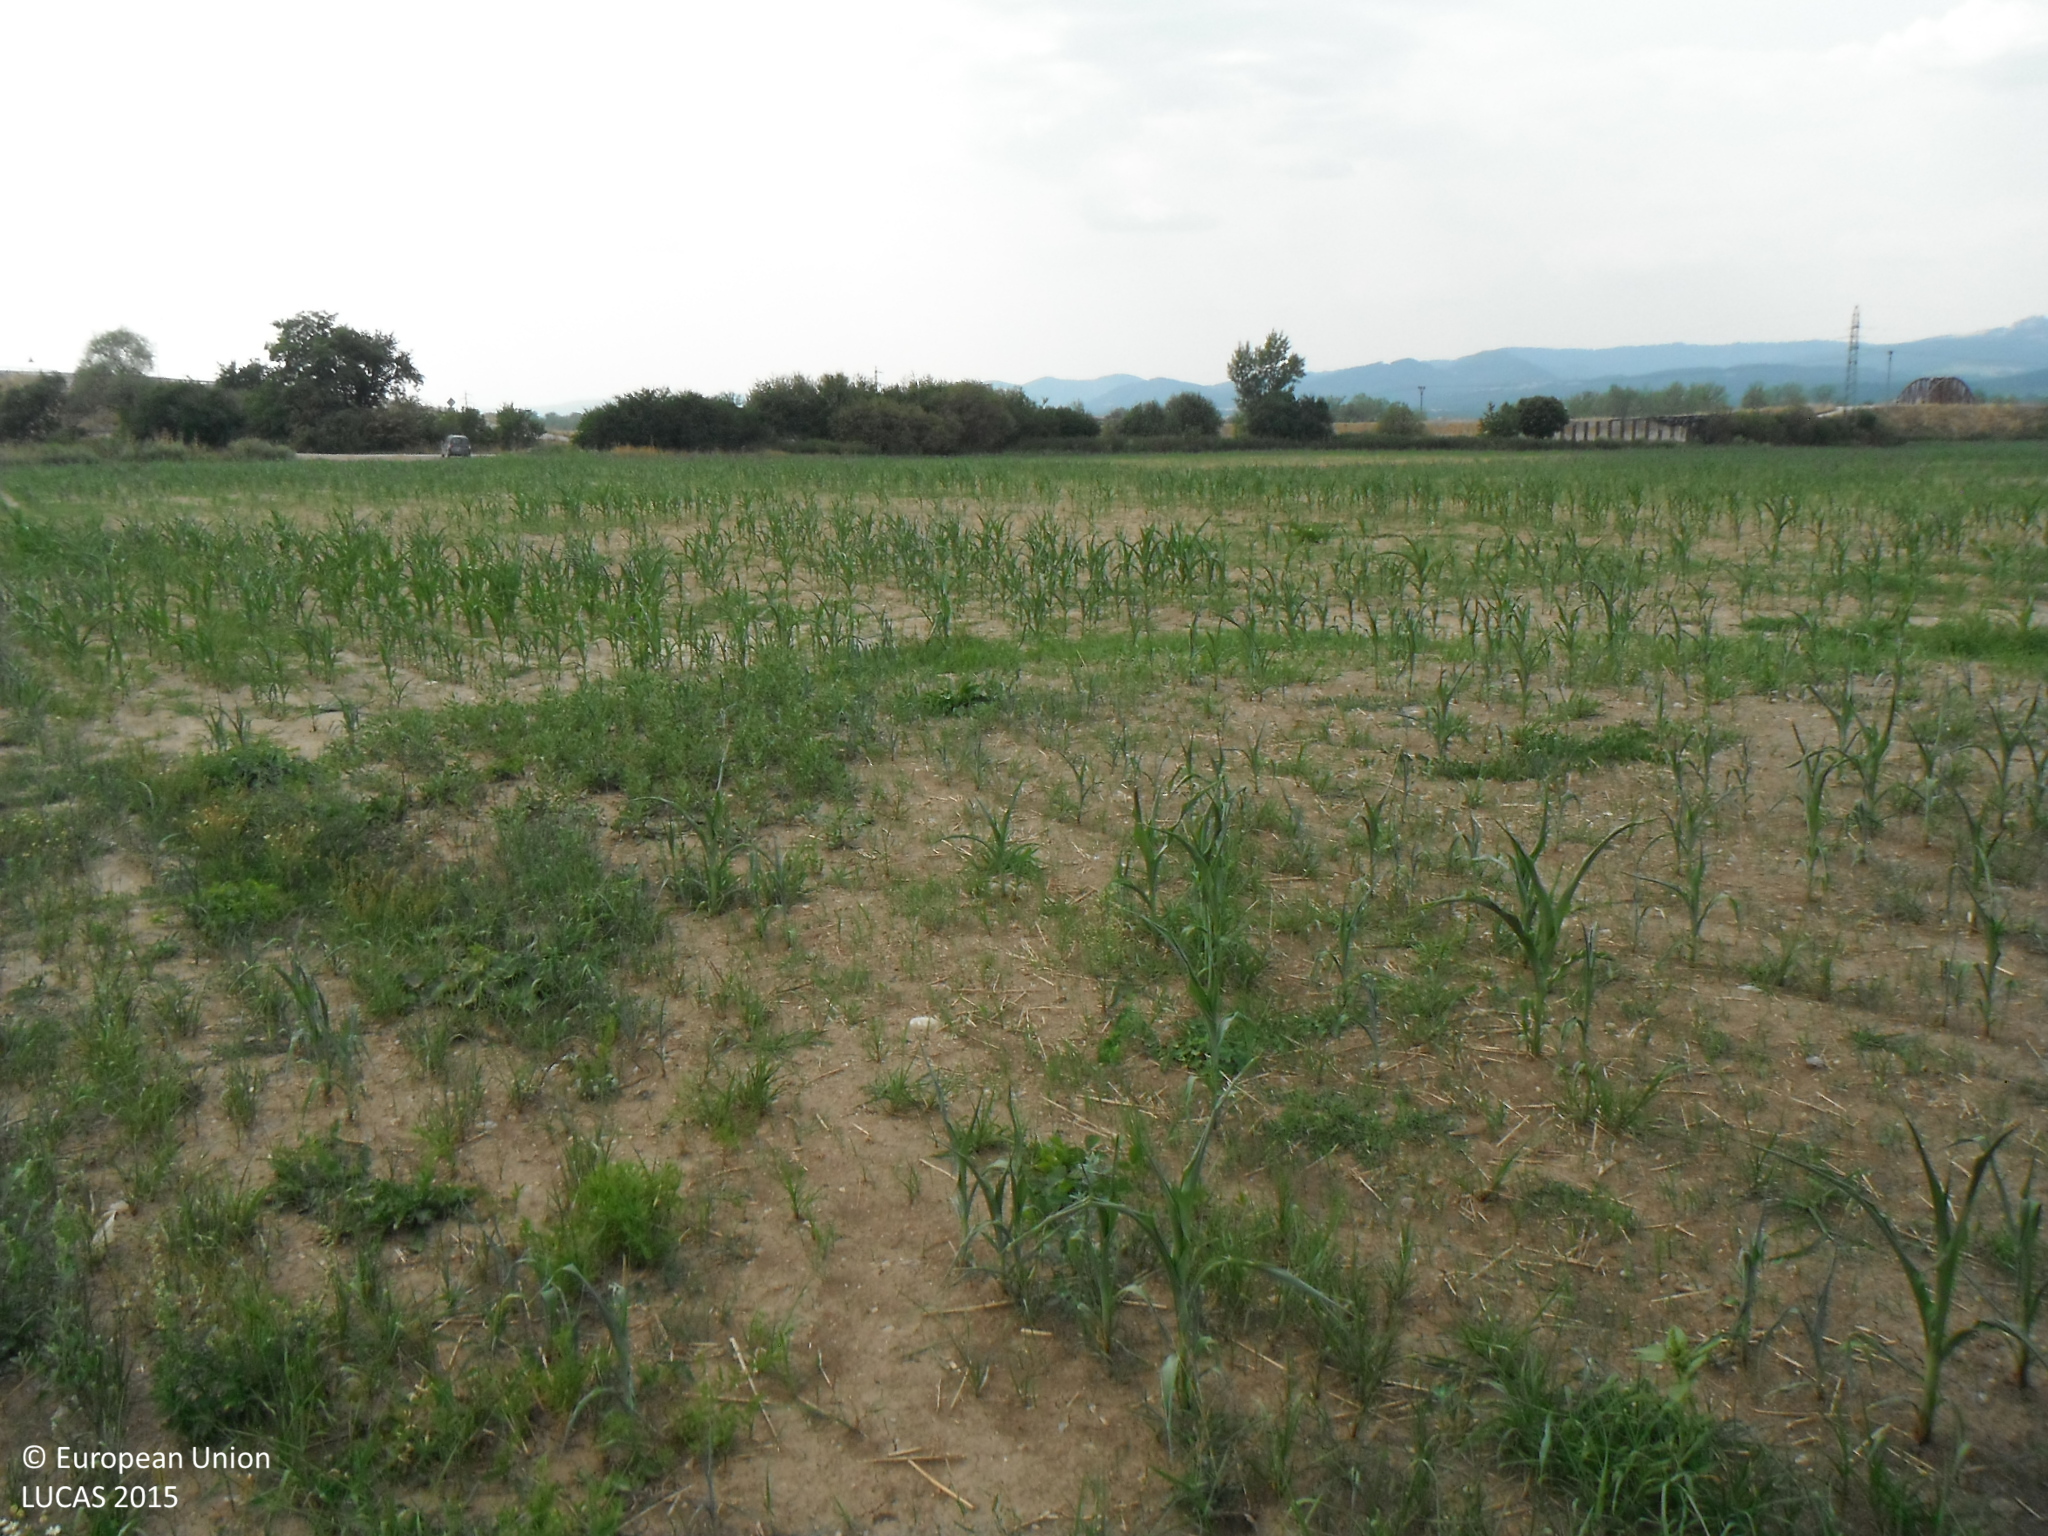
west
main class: Cropland
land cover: Maize
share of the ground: < 10 %
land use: Agriculture (excluding fallow land and kitchen gardens)
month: August
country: SK
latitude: 49.0163
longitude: 18.2611
